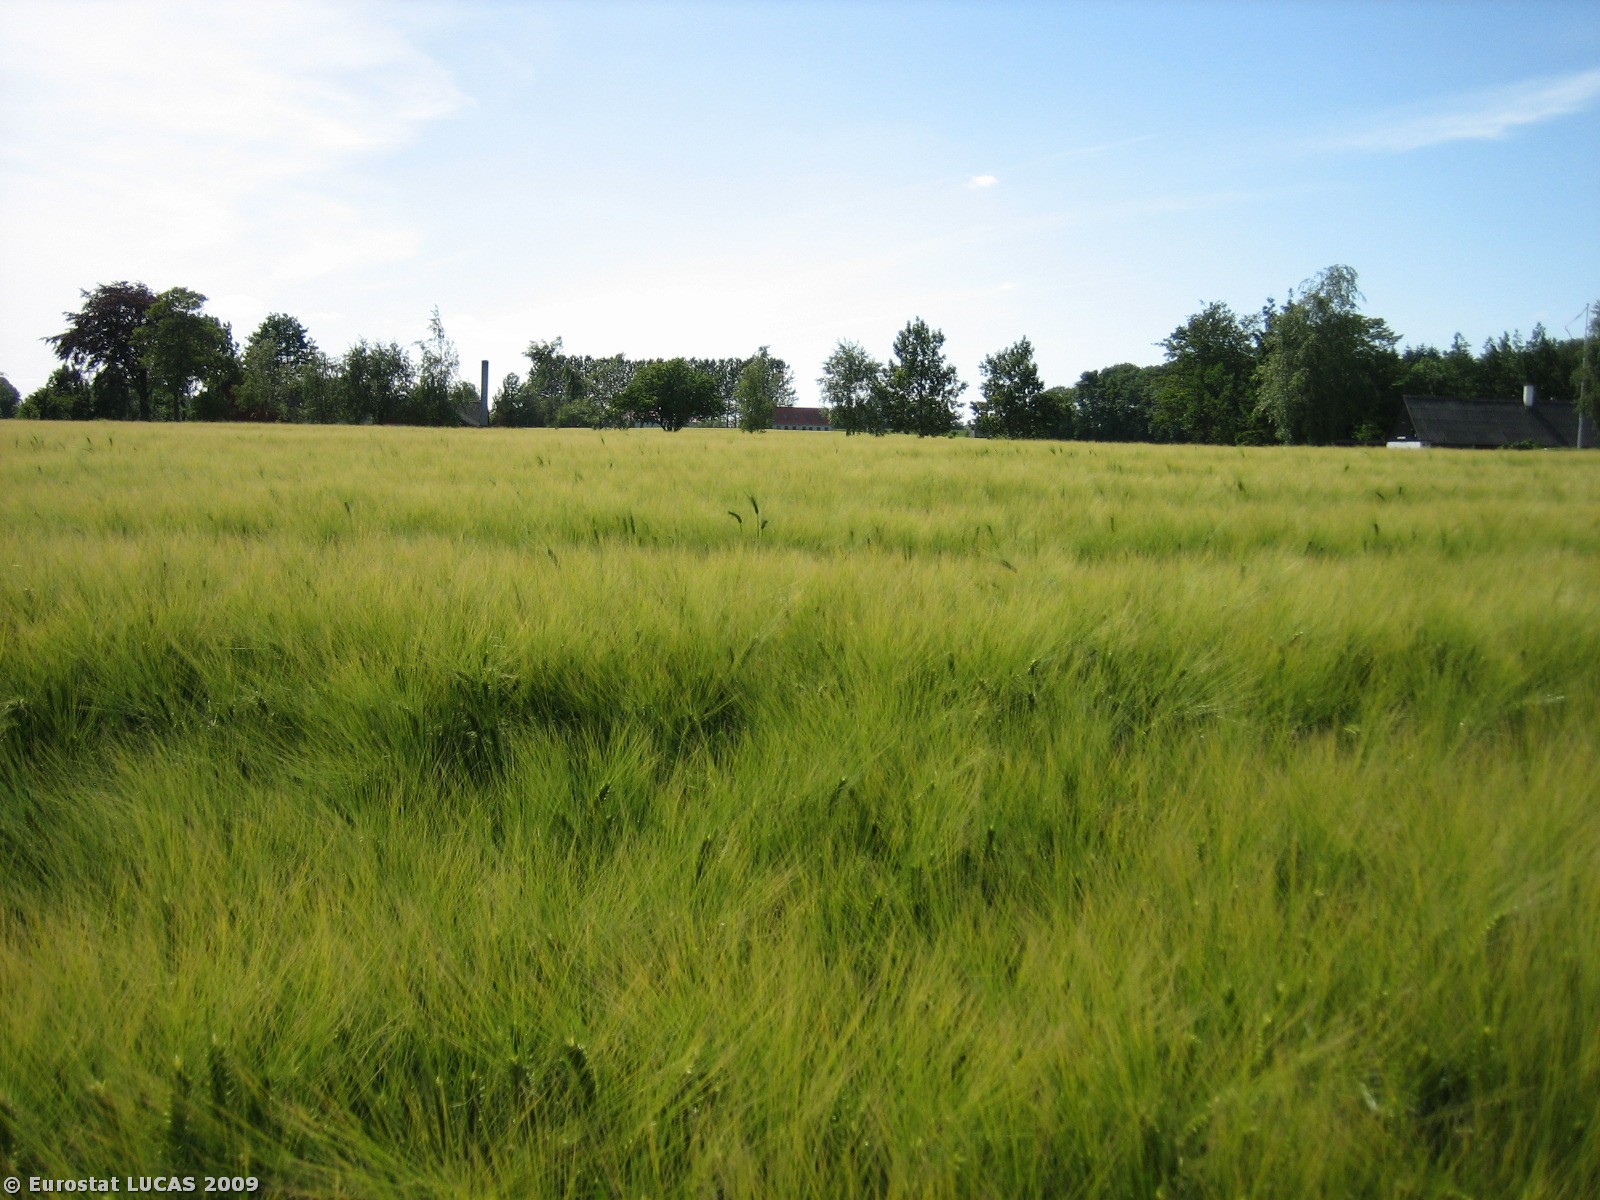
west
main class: Cropland
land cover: Barley
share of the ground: > 75 %
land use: Agriculture (excluding fallow land and kitchen gardens)
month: June
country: DK
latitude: 55.7203
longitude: 9.8569
